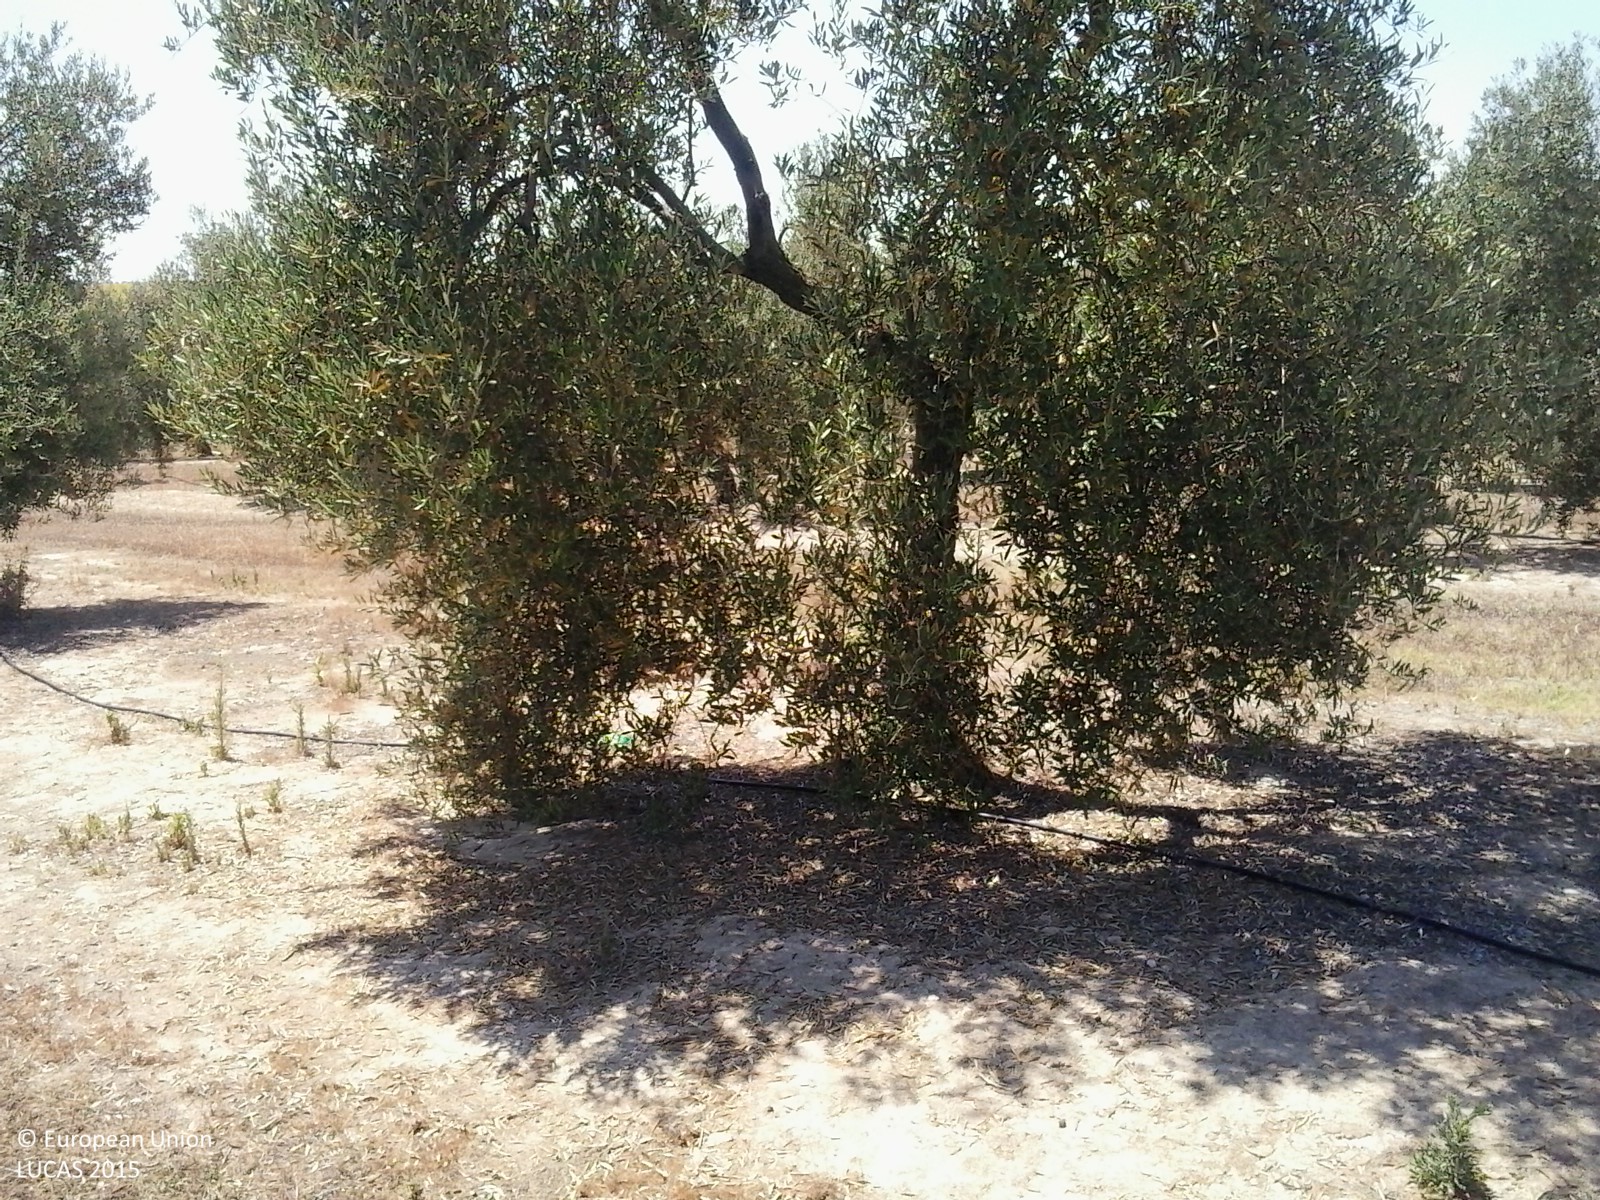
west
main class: Cropland
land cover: Olive groves
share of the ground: 25 - 50 %
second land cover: Spontaneously vegetated surfaces
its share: 10 - 25 %
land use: Agriculture (excluding fallow land and kitchen gardens)
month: June
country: ES
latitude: 37.3466
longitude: -6.2947
